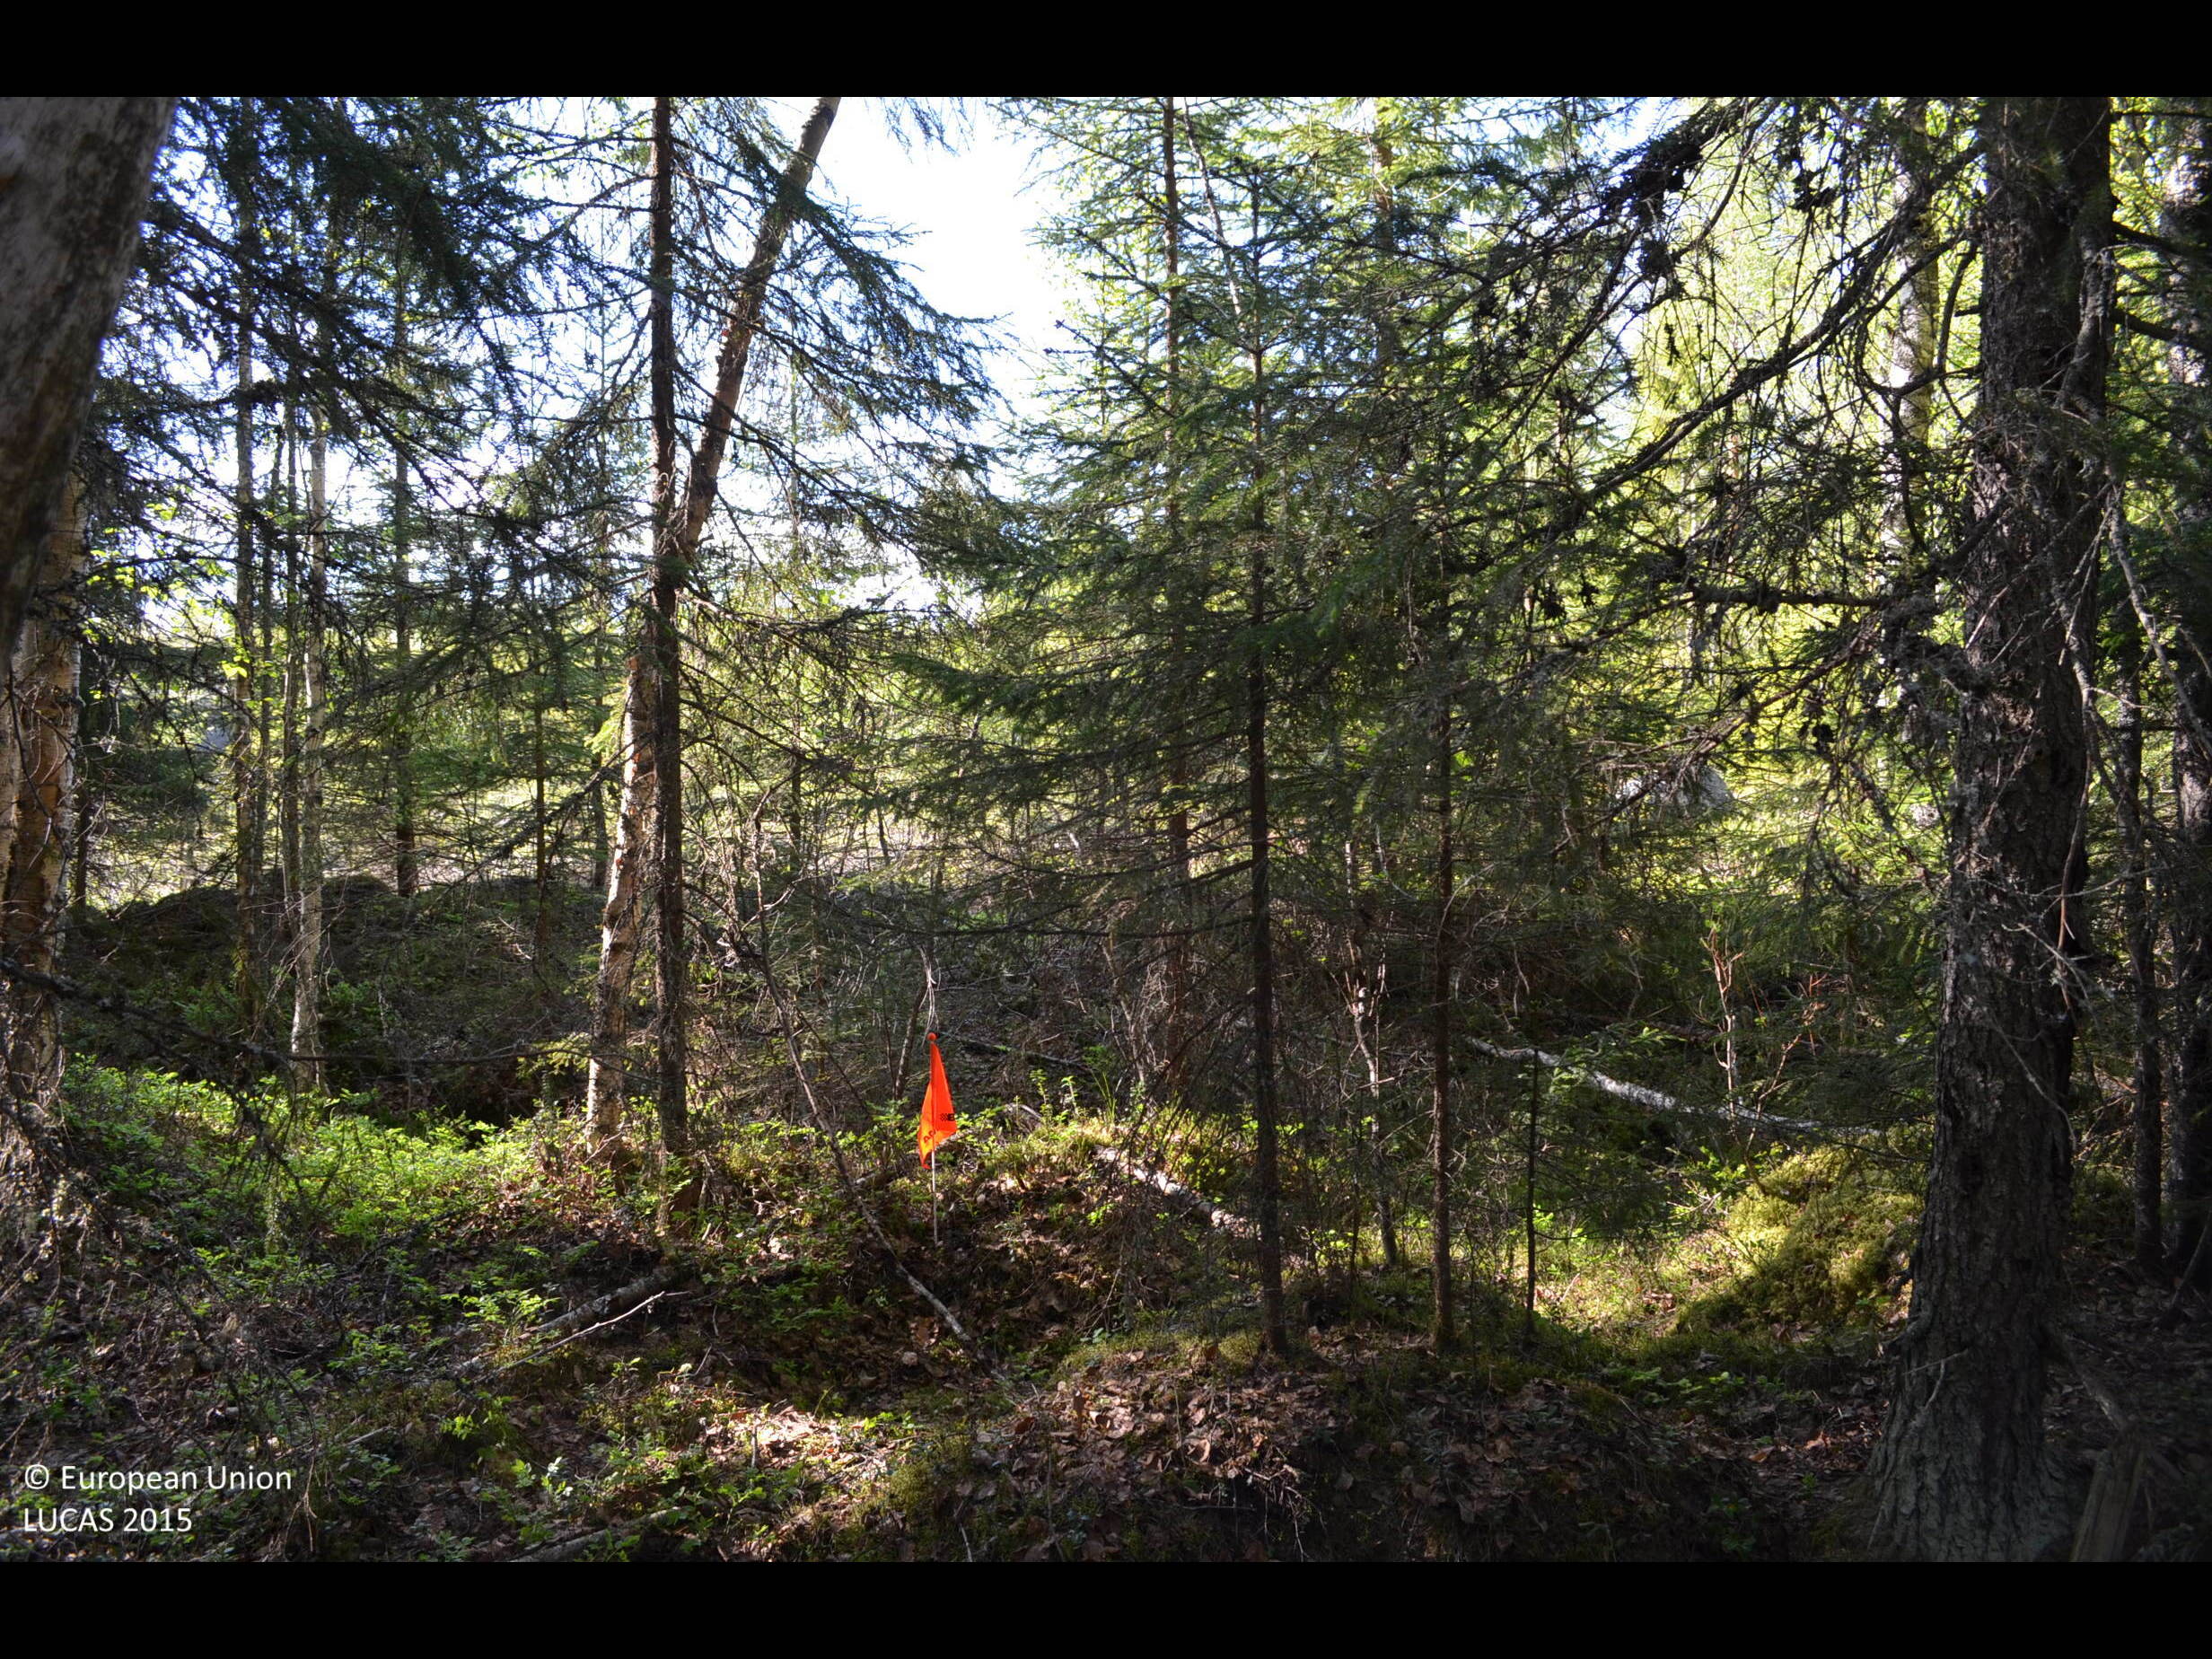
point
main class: Woodland
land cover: Pine dominated mixed woodland
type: boreal forest
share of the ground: > 75 %
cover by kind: coniferous forest trees 60 %, broadleaved forest trees 25 %, shrubs 10 %, lichens and mosses 5 %
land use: Forestry
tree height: > 5 m
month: June
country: FI
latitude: 61.8978
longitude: 23.2213
